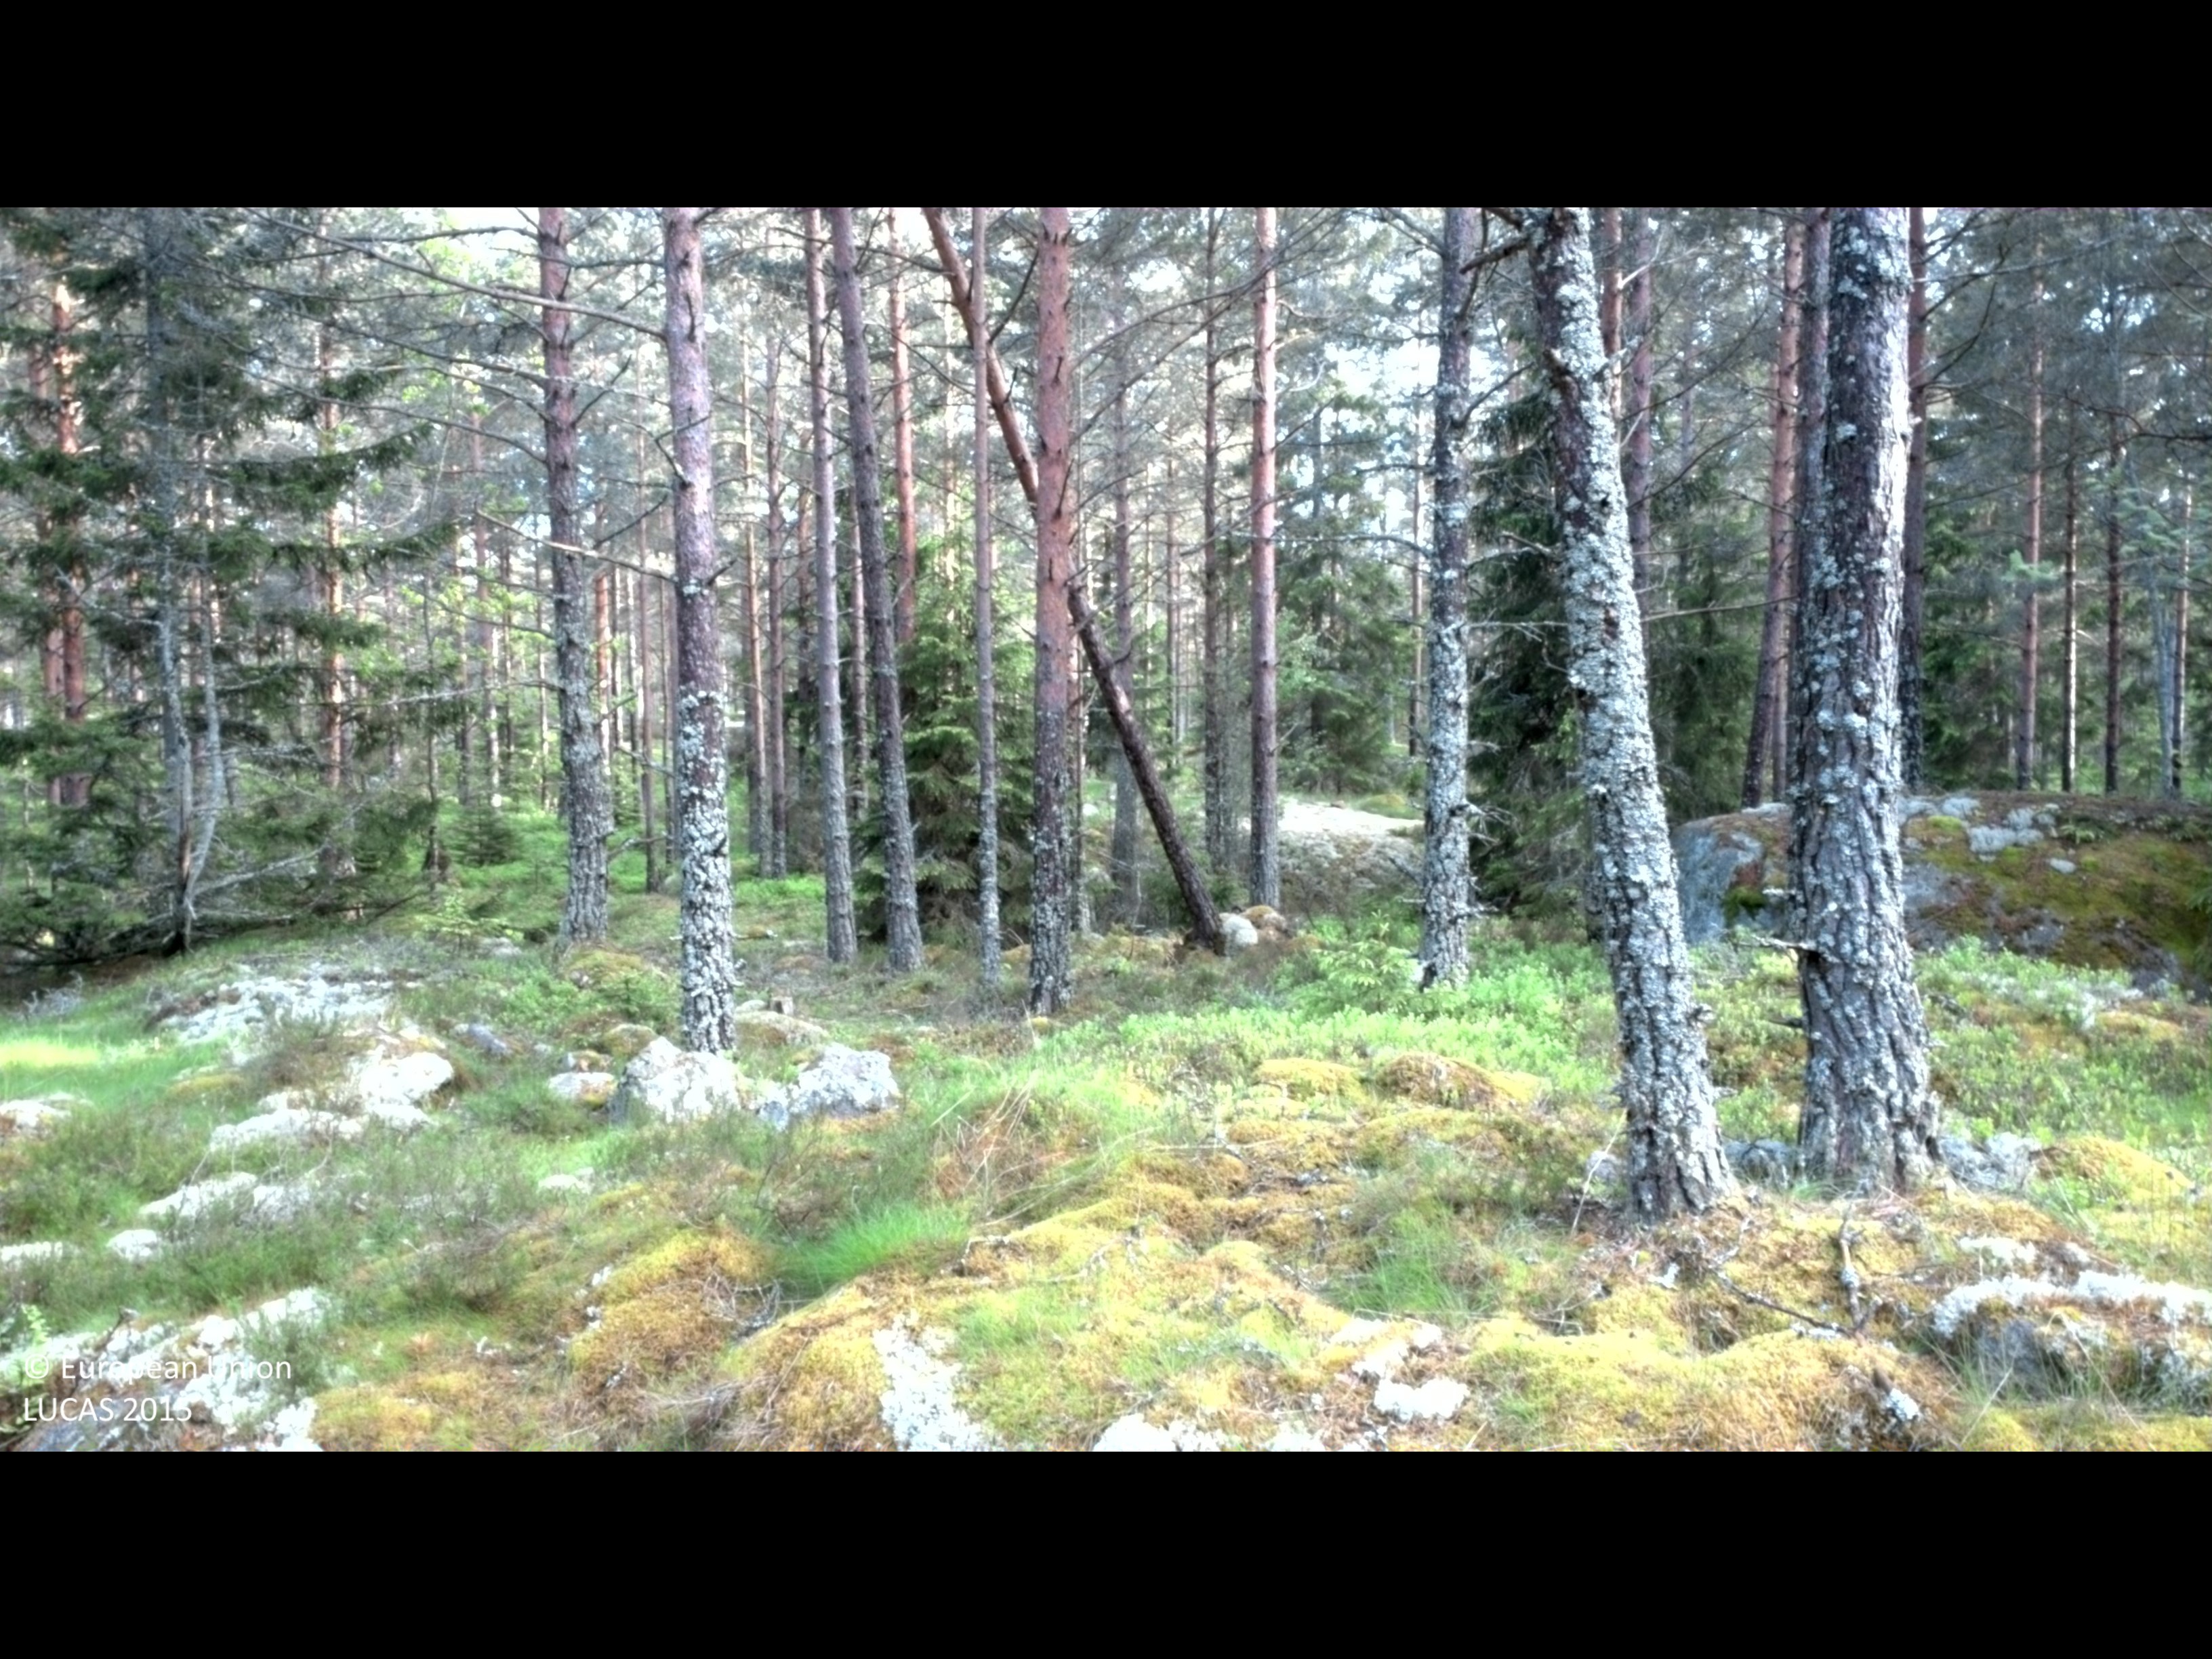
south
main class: Woodland
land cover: Pine dominated coniferous woodland
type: boreal forest
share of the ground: 25 - 50 %
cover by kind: coniferous forest trees 45 %, lichens and mosses 25 %, shrubs 15 %, broadleaved forest trees 5 %, herbaceous plants 5 %, consolidated bare surface 5 %
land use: Forestry
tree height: > 5 m
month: May
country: SE
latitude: 57.4299
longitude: 16.5116
